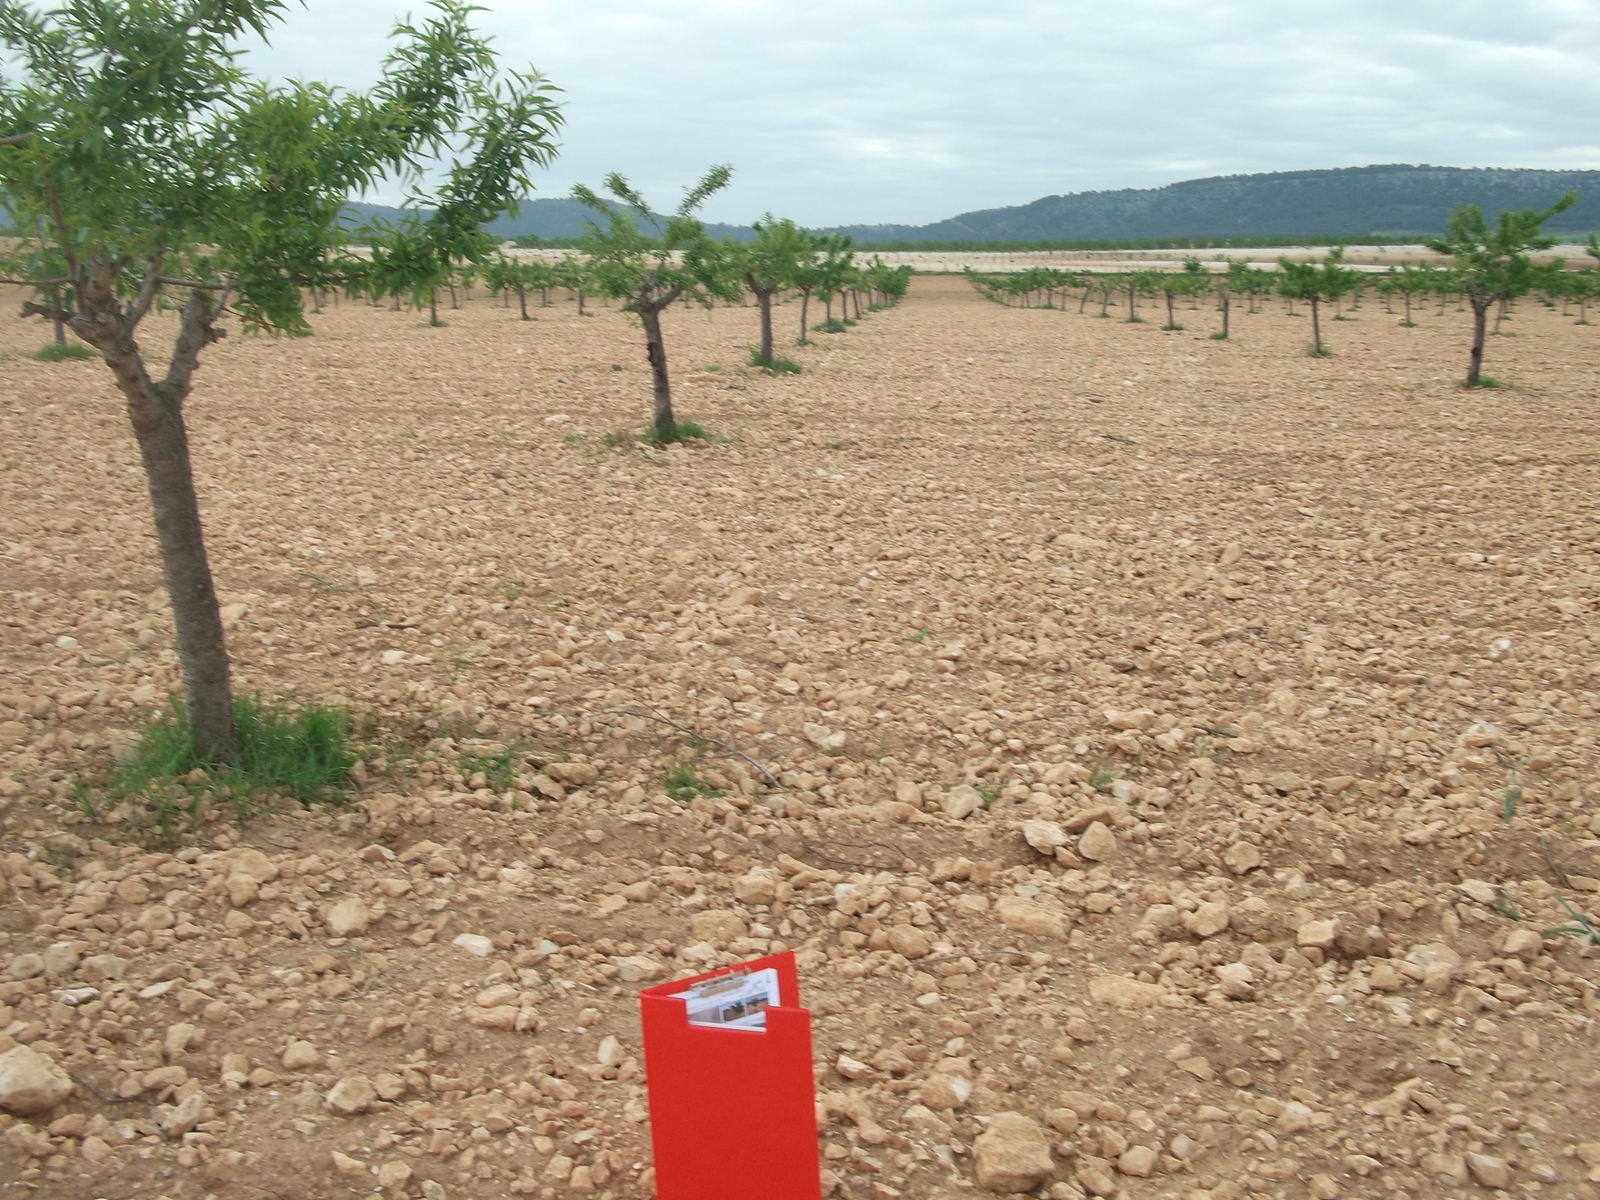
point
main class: Cropland
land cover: Nuts trees
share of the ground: < 10 %
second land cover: Other bare soil
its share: > 75 %
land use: Agriculture (excluding fallow land and kitchen gardens)
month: April
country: ES
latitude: 38.1038
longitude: -1.5397
